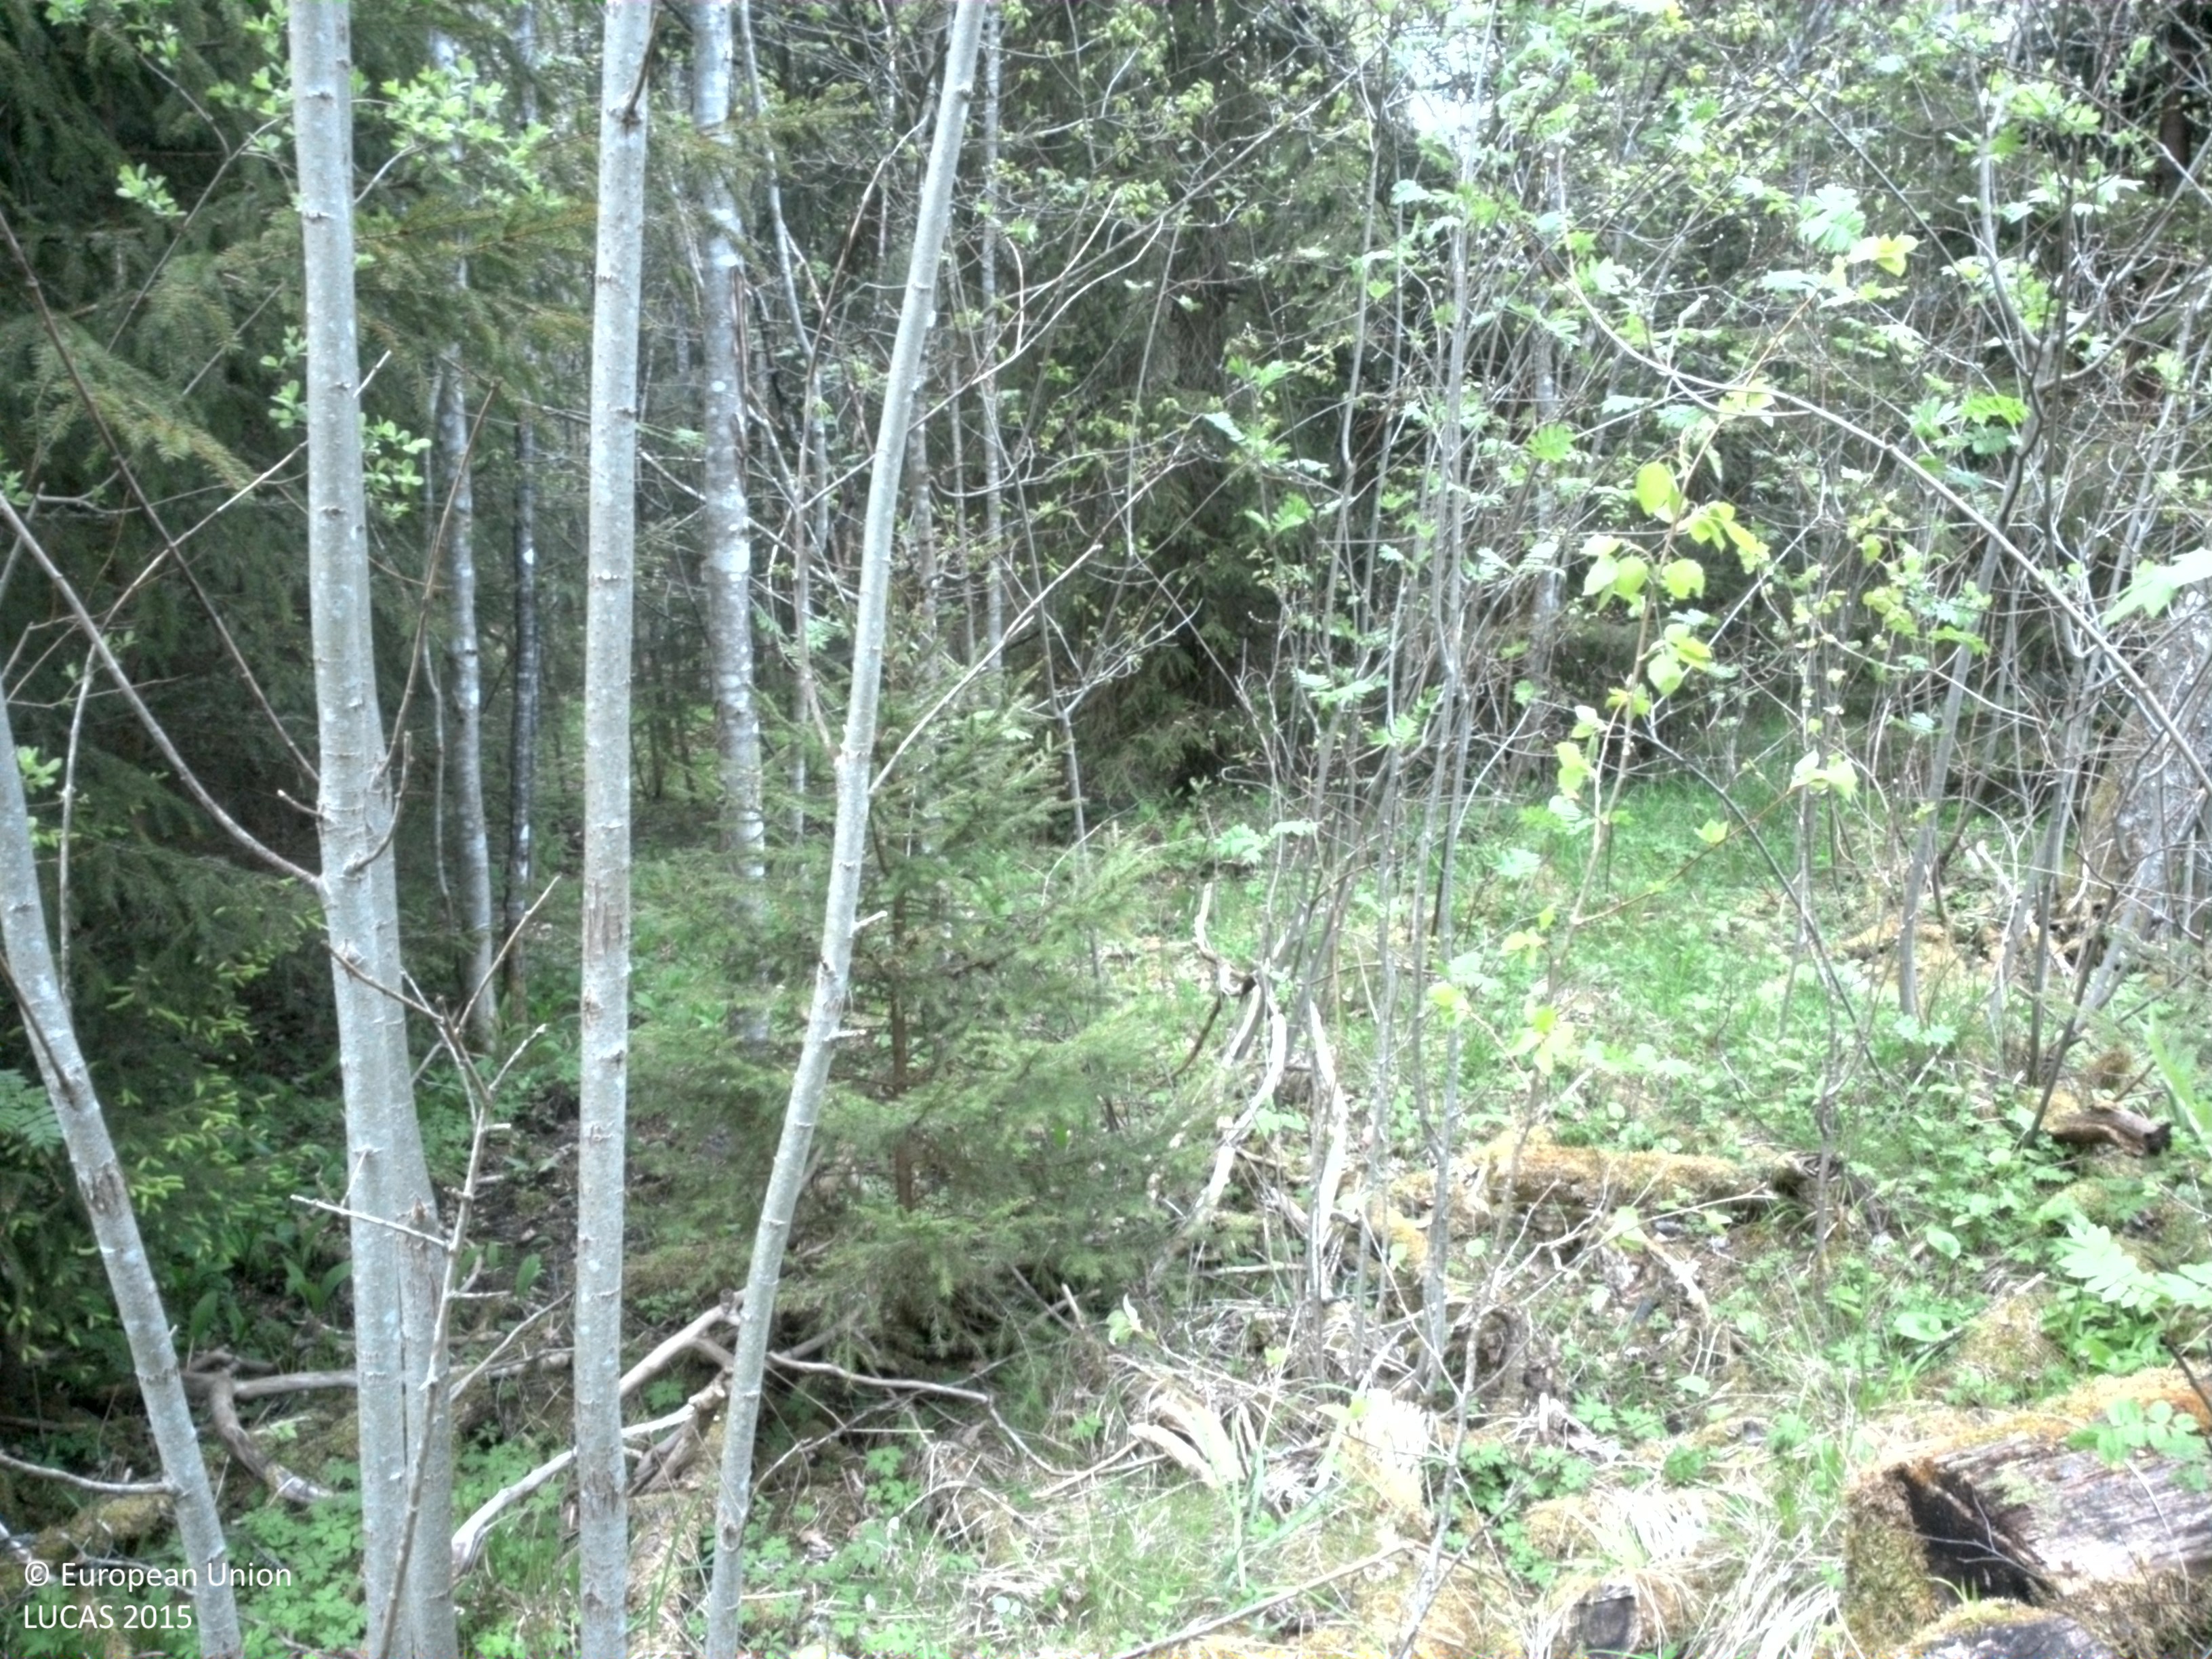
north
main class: Woodland
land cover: Broadleaved woodland
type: boreal forest
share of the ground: 50 - 75 %
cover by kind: broadleaved forest trees 65 %, shrubs 15 %, coniferous forest trees 10 %, herbaceous plants 10 %
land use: Forestry
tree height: > 5 m
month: May
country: SE
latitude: 56.6397
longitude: 15.2322
